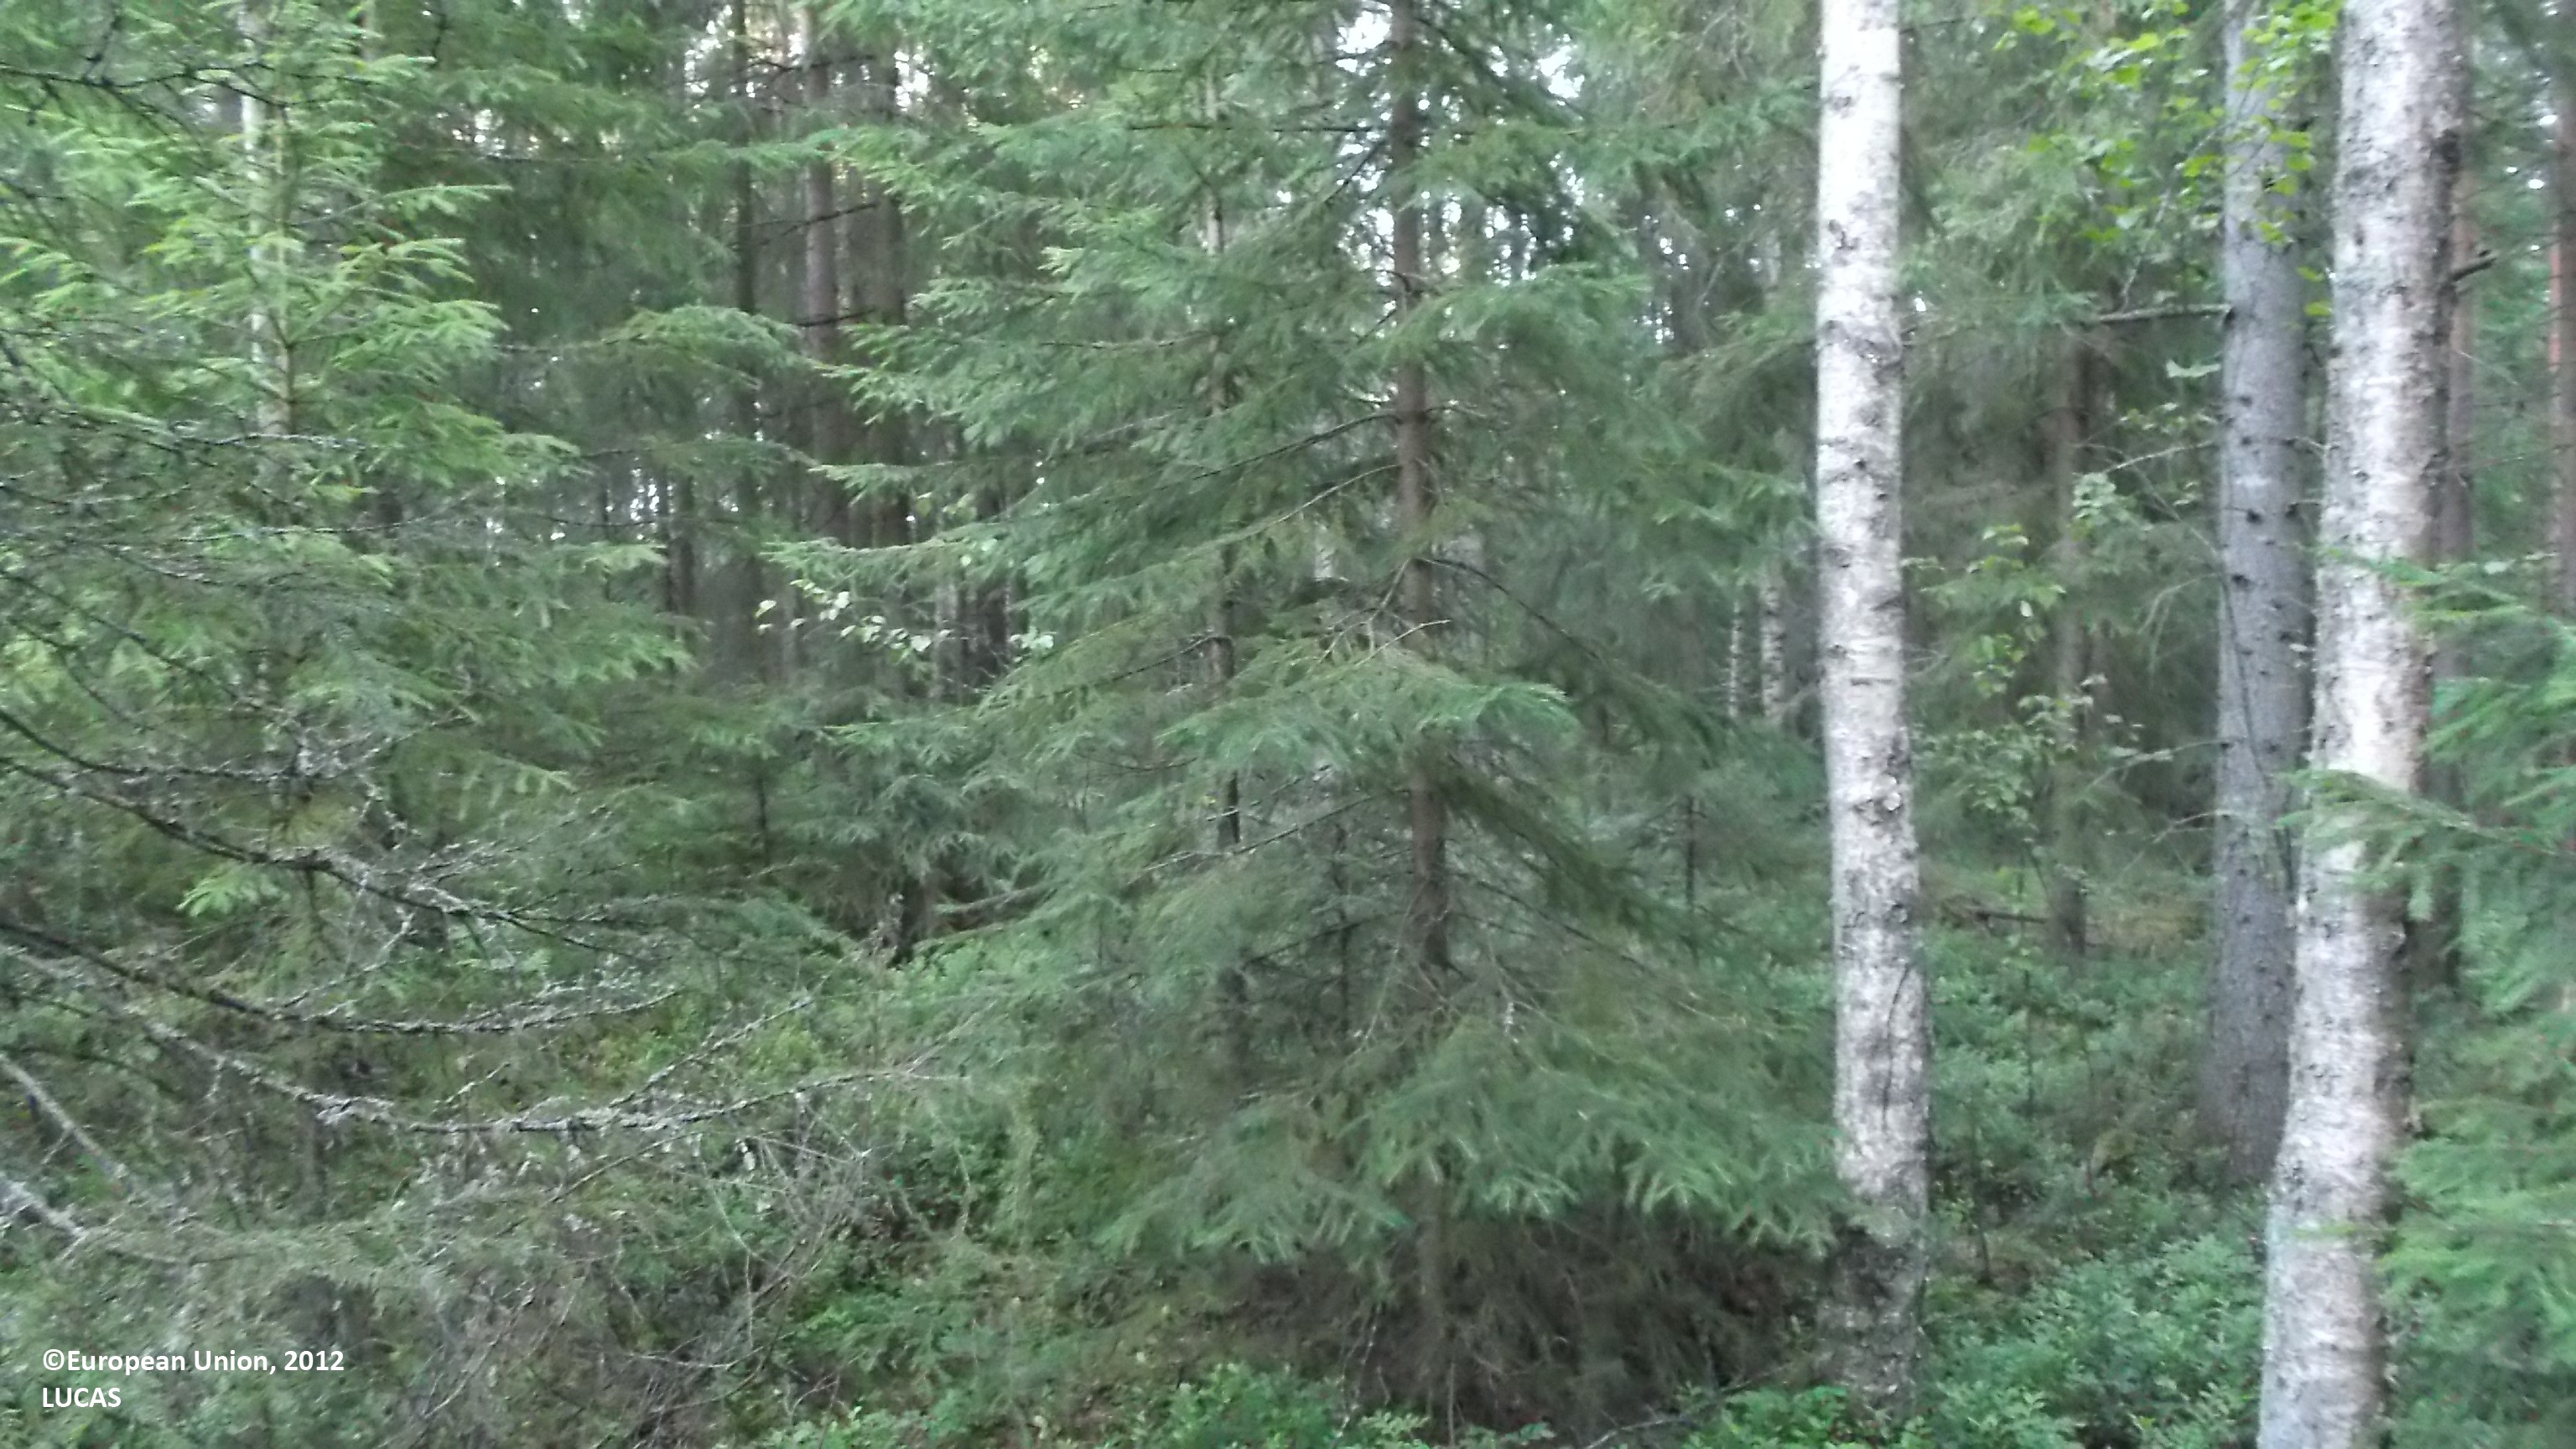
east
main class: Woodland
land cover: Spruce dominated mixed woodland
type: boreal forest
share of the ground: > 75 %
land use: Forestry
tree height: > 5 m
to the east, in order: Spruce dominated mixed woodland; Other mixed woodland; Grassland with sparse tree/shrub cover; Other mixed woodland; Ditches and canals; Other mixed woodland; Grassland with sparse tree/shrub cover; Spruce dominated mixed woodland; Ditches and canals; Spruce dominated mixed woodland; Ditches and canals; Spruce dominated mixed woodland; Ditches and canals; Spontaneously vegetated surfaces; Spruce dominated mixed woodland
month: July
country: FI
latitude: 63.5938
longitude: 23.7497
